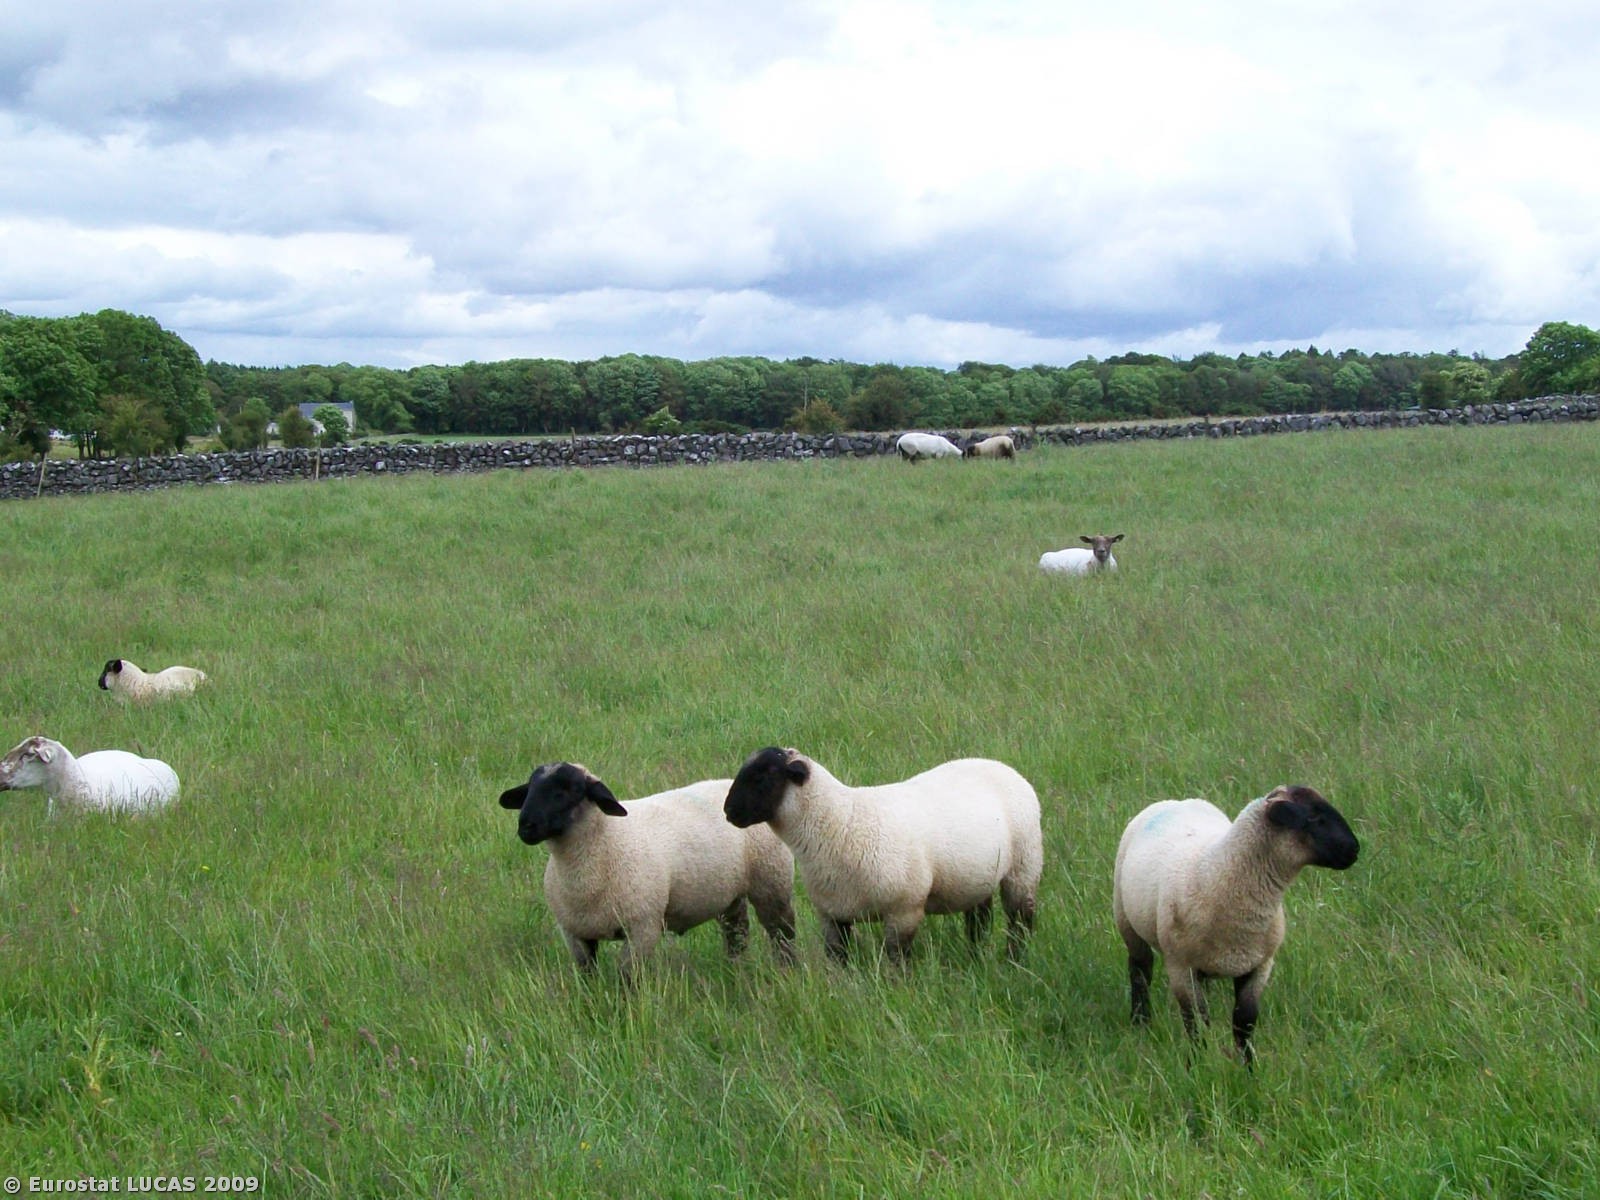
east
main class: Grassland
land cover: Grassland without tree/shrub cover
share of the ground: > 75 %
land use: Agriculture (excluding fallow land and kitchen gardens)
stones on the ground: < 10 %
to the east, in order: Grassland without tree/shrub cover; Dry stone walls; Grassland without tree/shrub cover; Dry stone walls; Grassland without tree/shrub cover; Dry stone walls; Grassland without tree/shrub cover
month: June
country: IE
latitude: 53.3366
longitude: -8.7810
